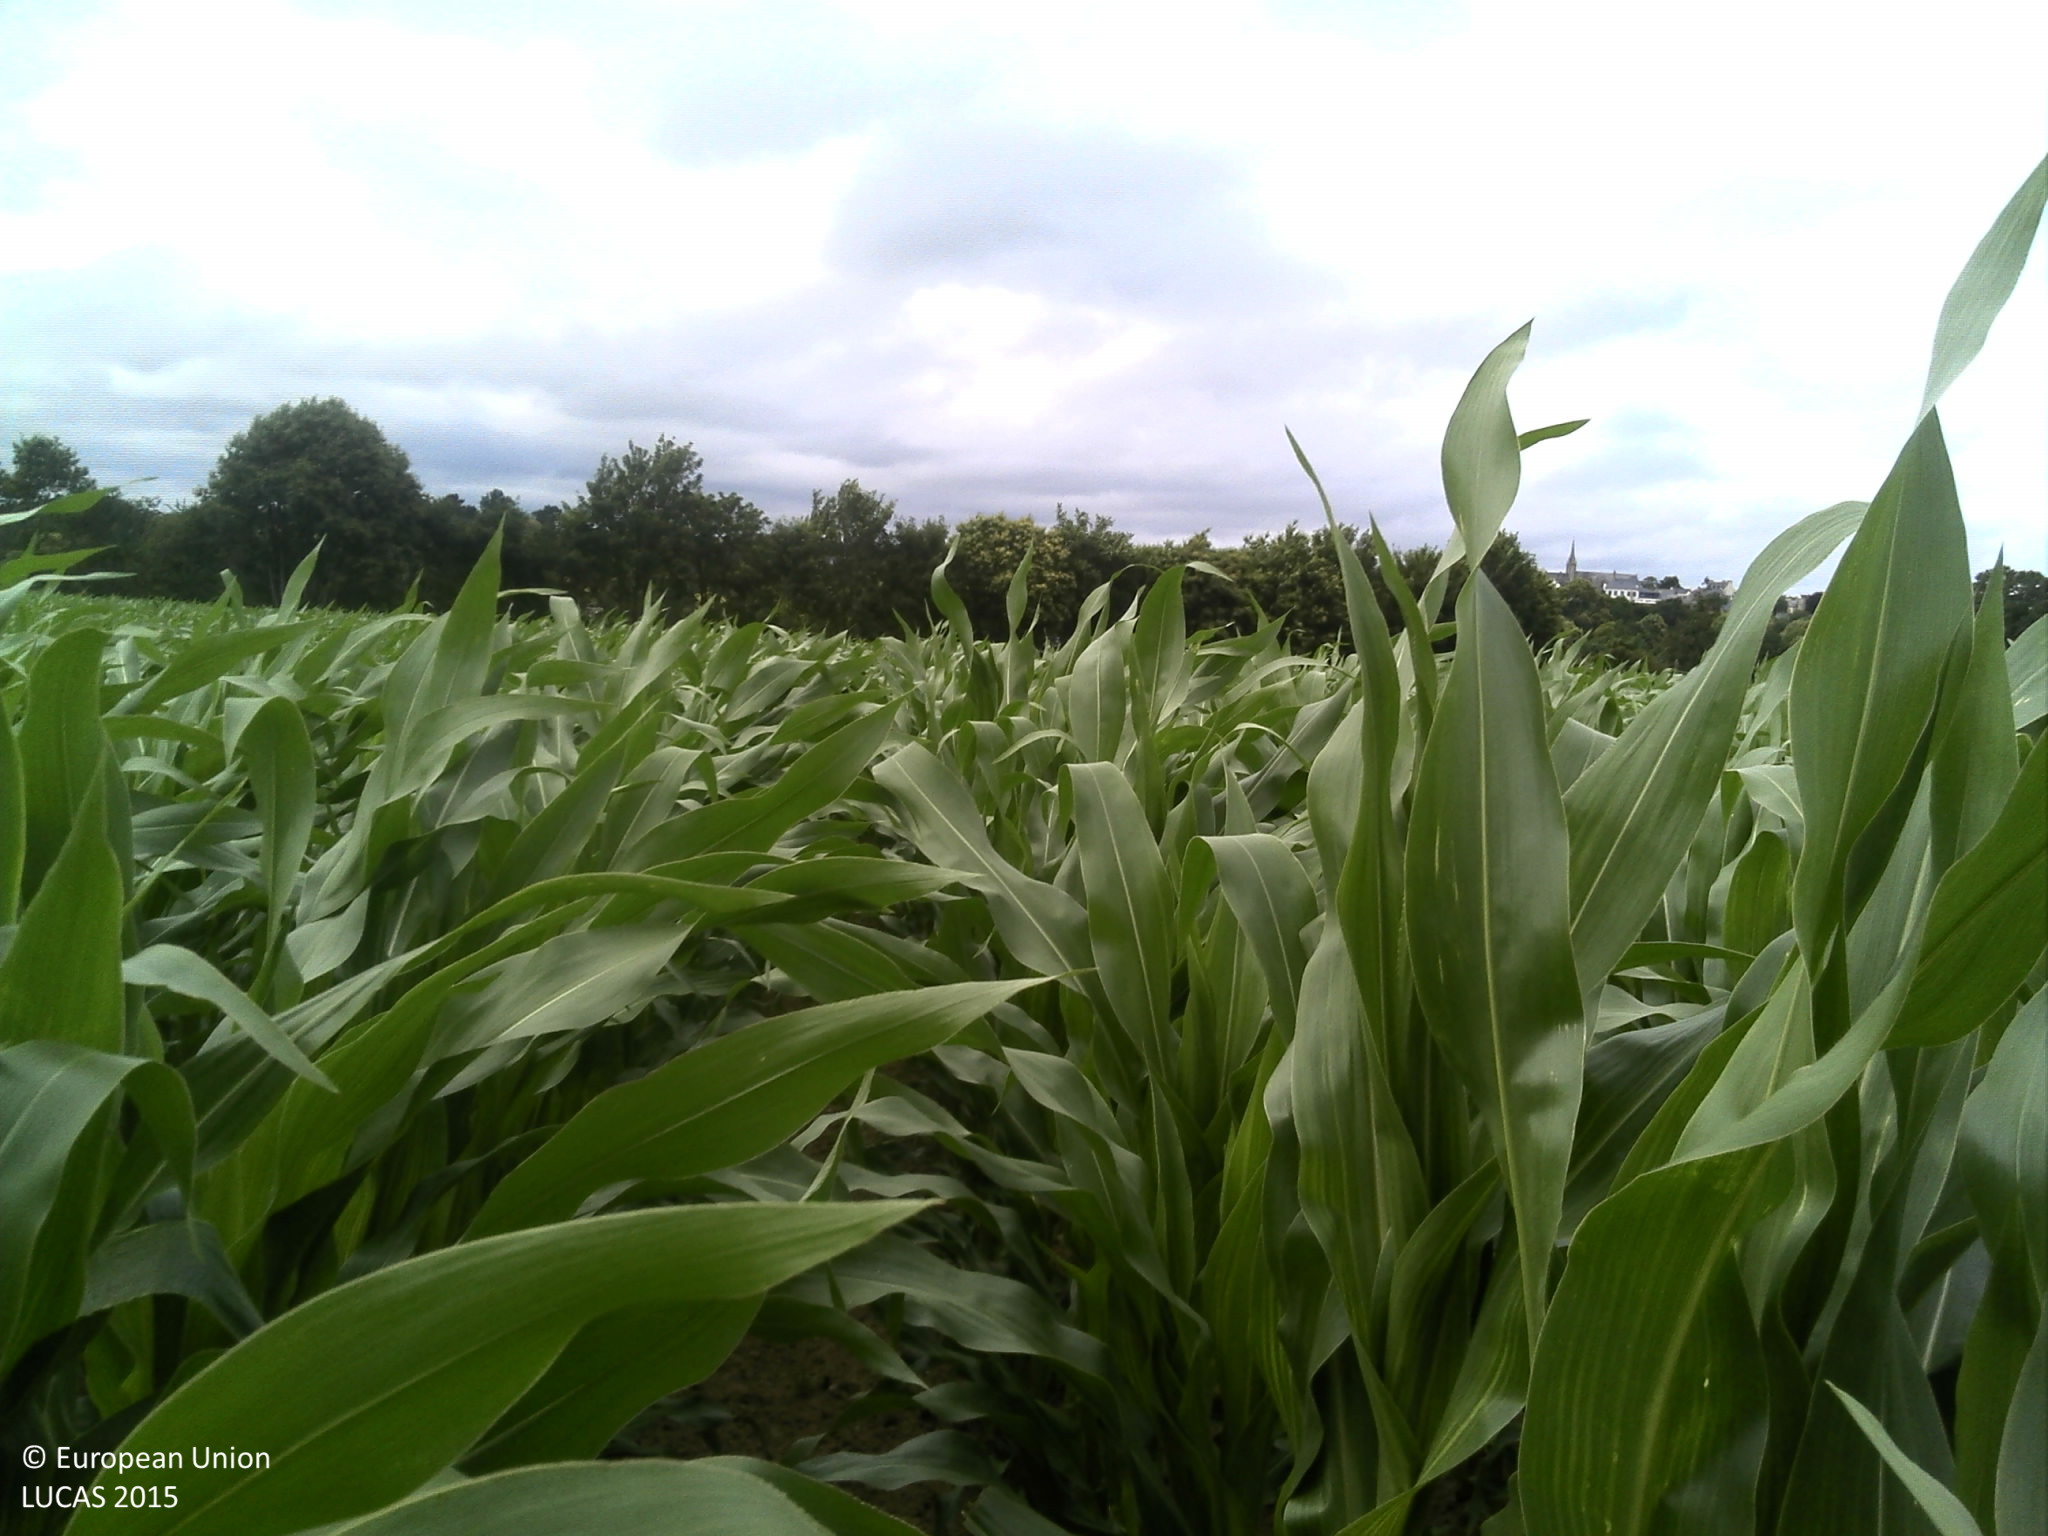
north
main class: Cropland
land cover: Maize
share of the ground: > 75 %
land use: Agriculture (excluding fallow land and kitchen gardens)
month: July
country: FR
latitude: 48.5110
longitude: -3.7145
